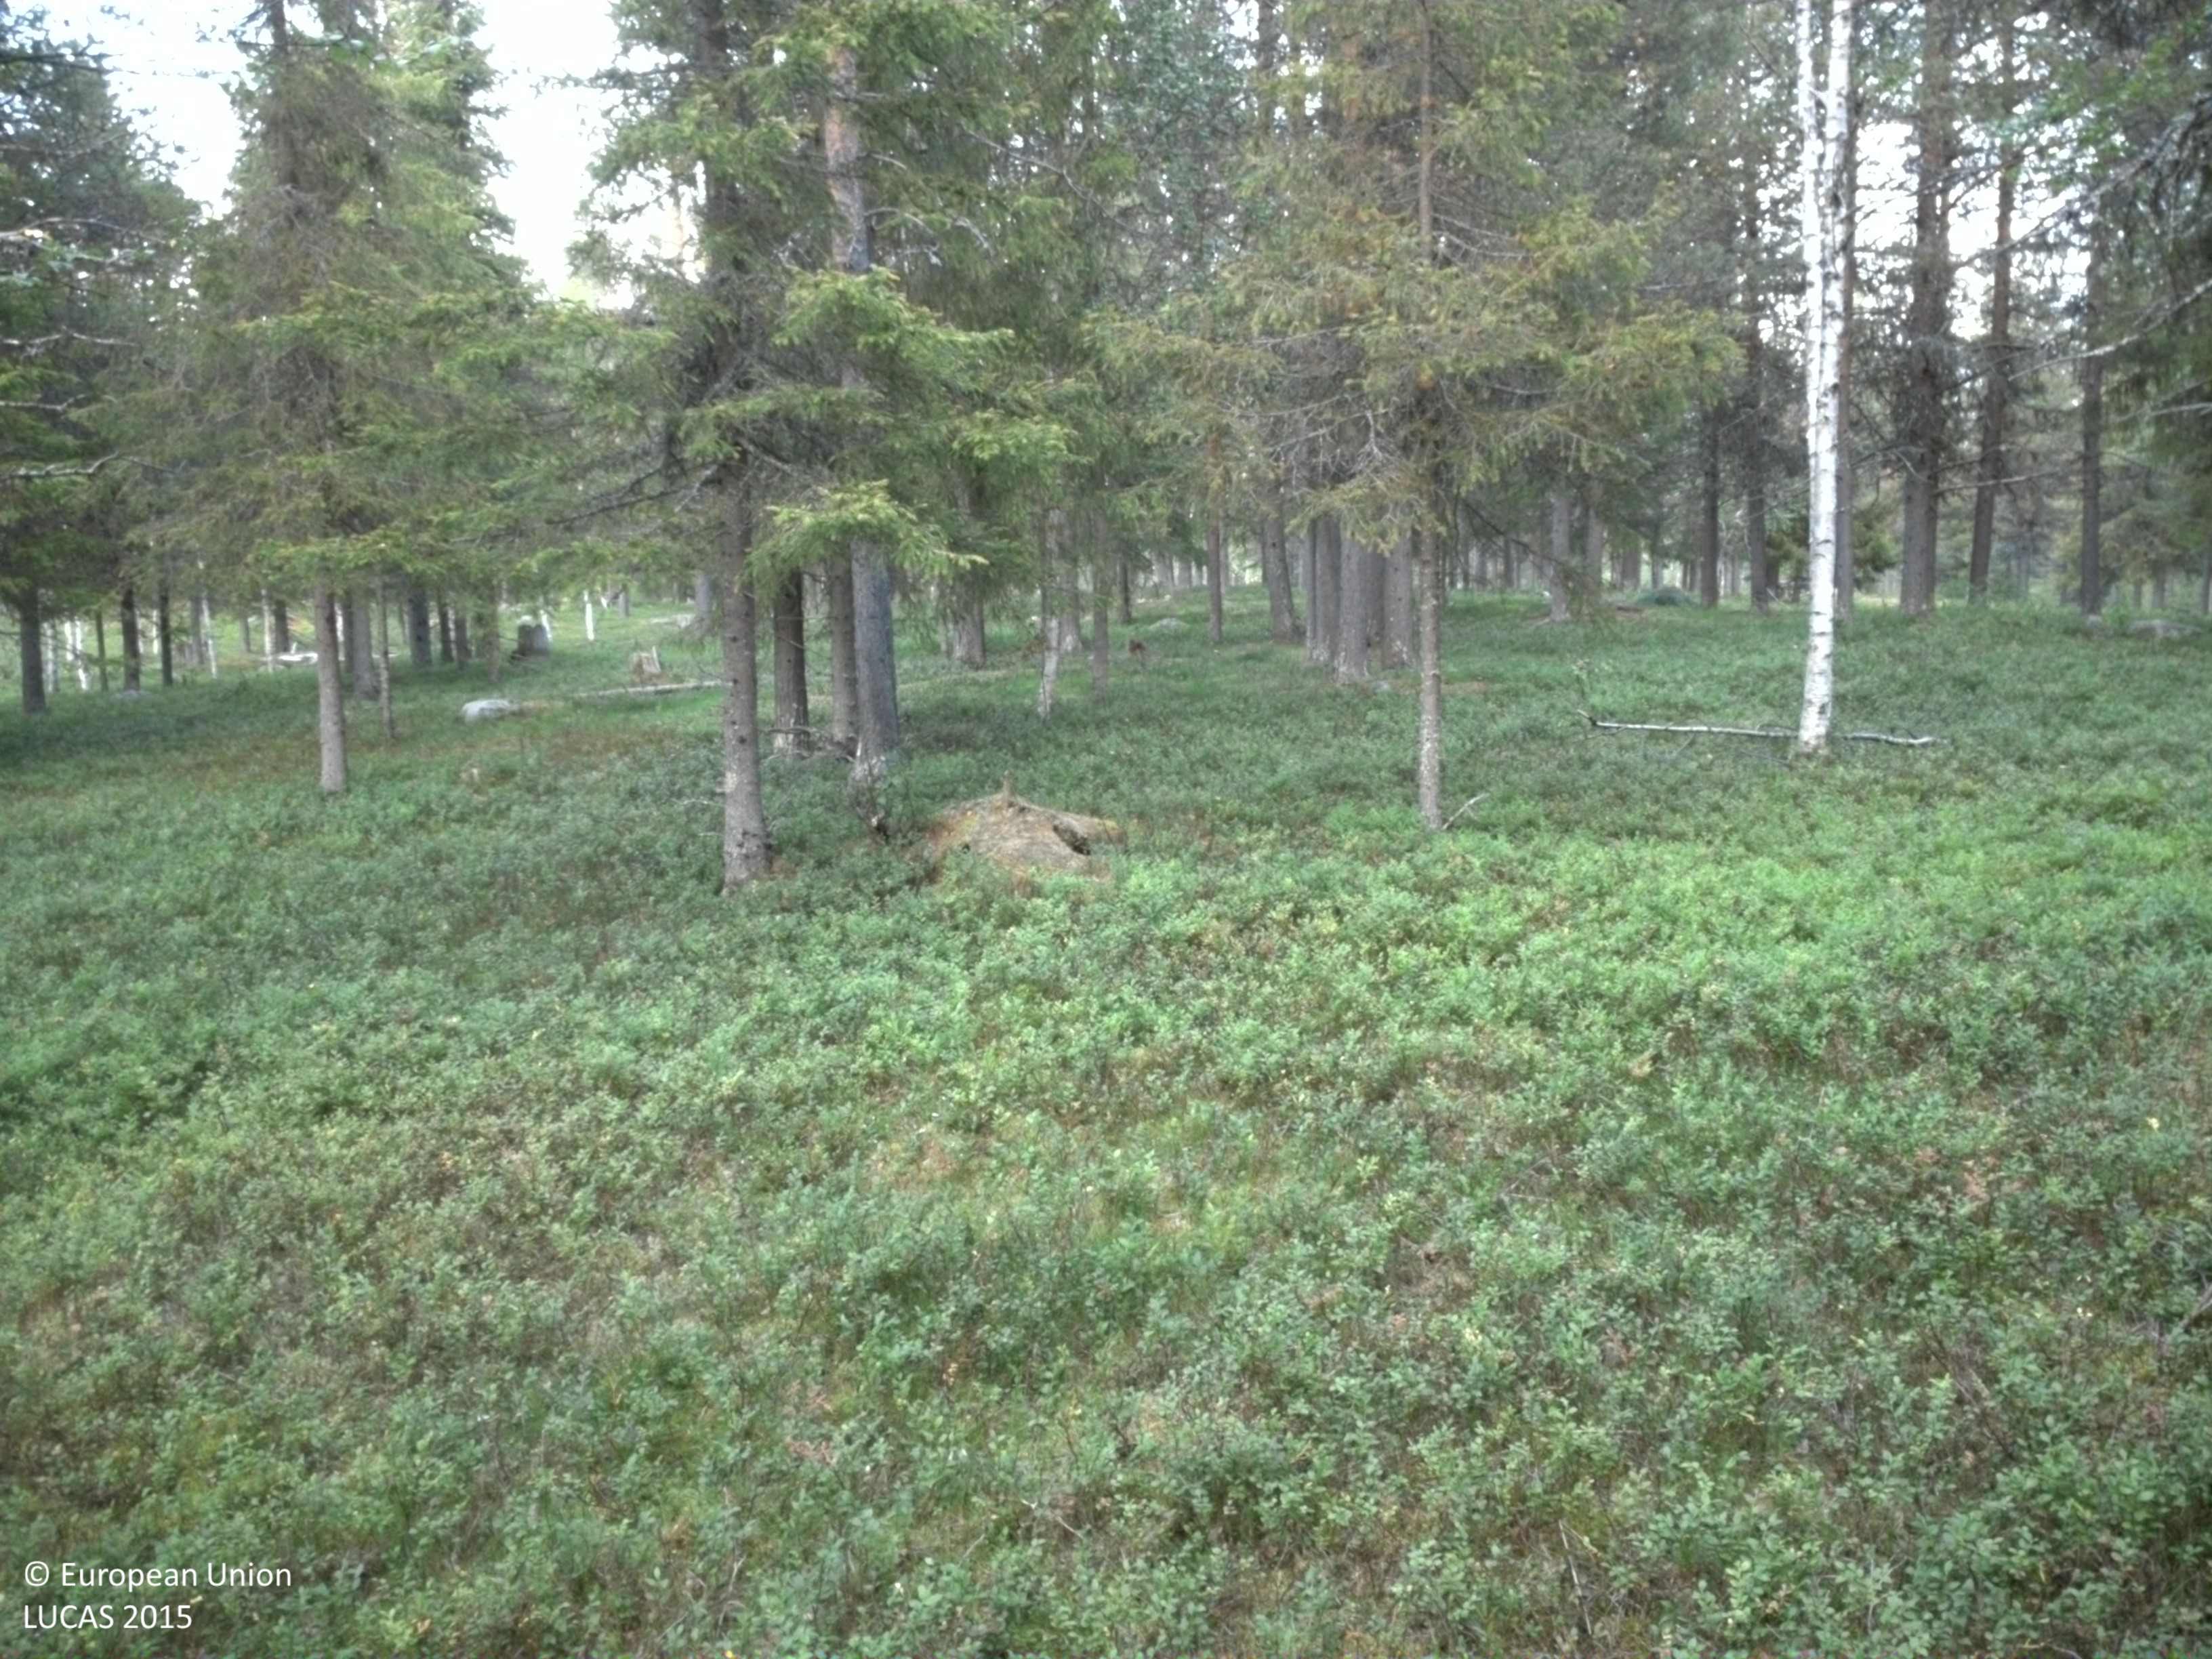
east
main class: Woodland
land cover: Pine dominated coniferous woodland
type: boreal forest
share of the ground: 25 - 50 %
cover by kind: shrubs 55 %, coniferous forest trees 30 %, broadleaved forest trees 5 %, herbaceous plants 5 %, lichens and mosses 5 %
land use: Forestry
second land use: Other primary production
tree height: > 5 m
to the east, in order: Pine dominated coniferous woodland; Fences; Pine dominated mixed woodland; Rocks and stones; Ditches and canals; Paved roads, cycling and walking lanes; Ditches and canals; Pine dominated coniferous woodland; Spruce dominated coniferous woodland; Broadleaved woodland
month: August
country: SE
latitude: 66.6553
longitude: 20.6065
